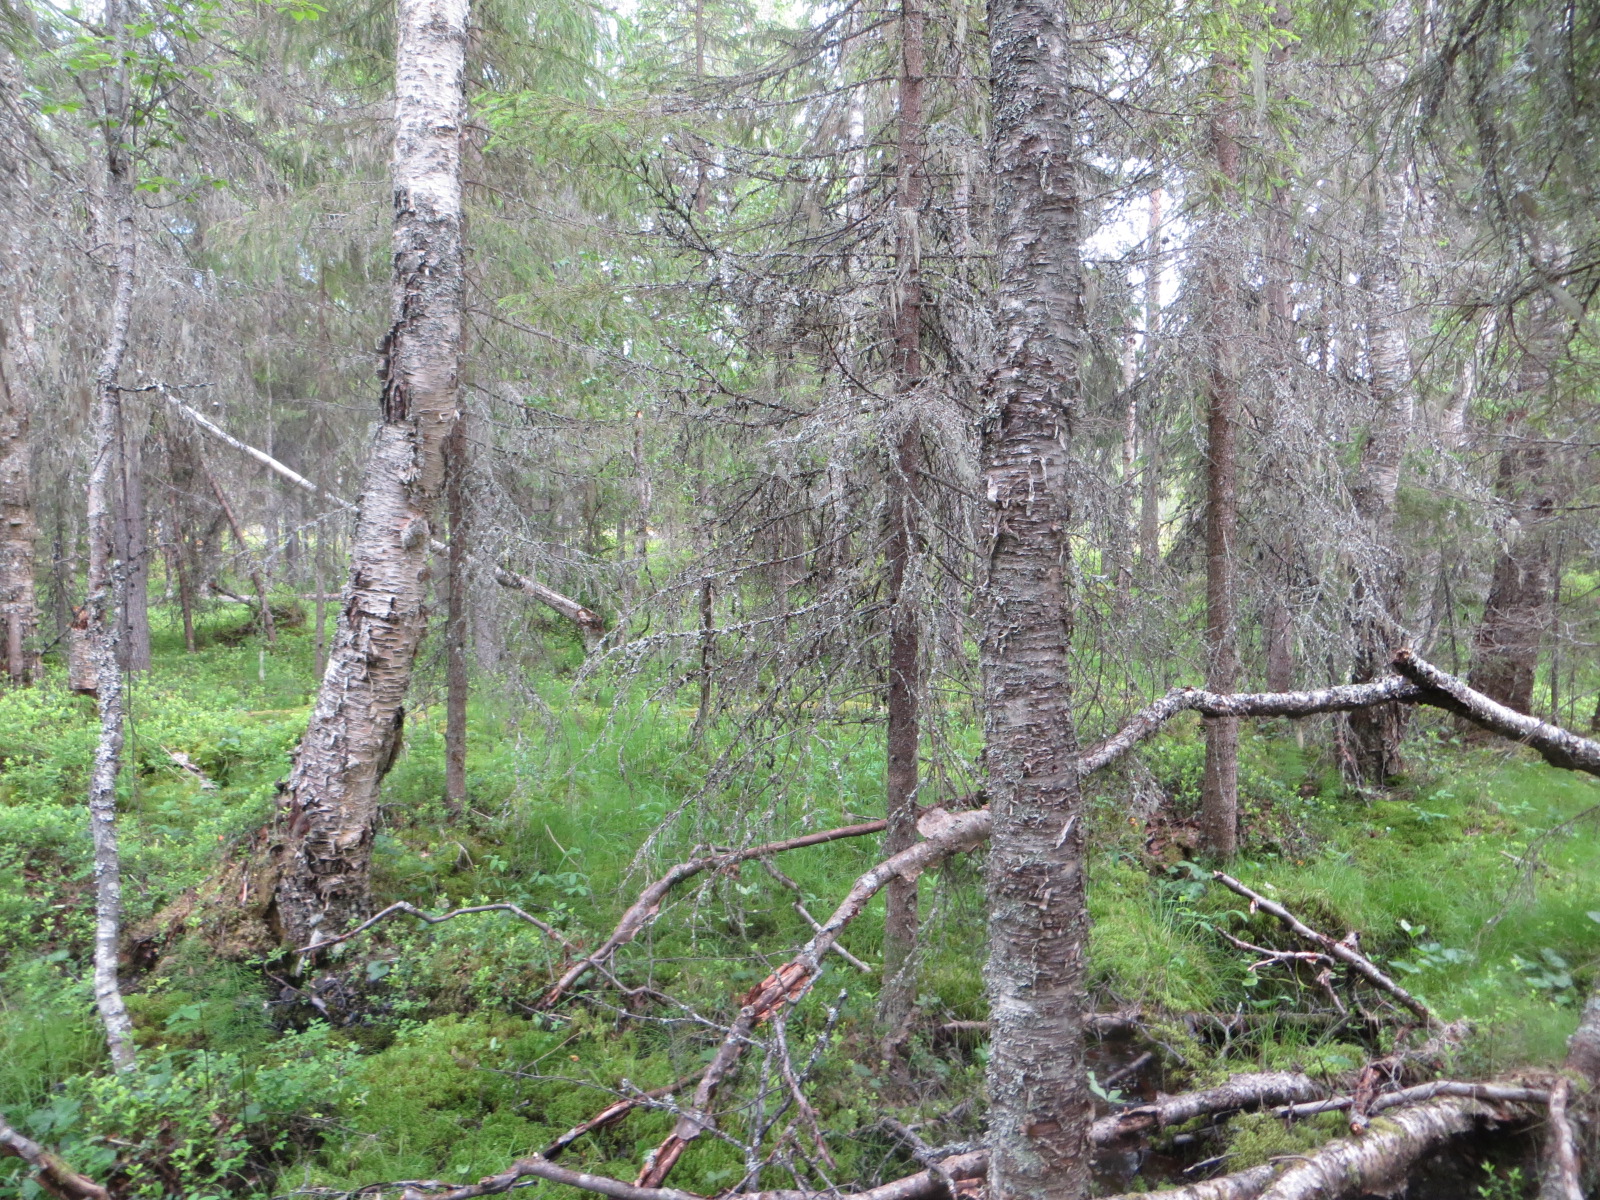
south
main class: Woodland
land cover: Spruce dominated mixed woodland
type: mire and swamp forests
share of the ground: 50 - 75 %
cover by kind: coniferous forest trees 40 %, broadleaved forest trees 30 %, shrubs 25 %, lichens and mosses 5 %
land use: Forestry
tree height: > 5 m
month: July
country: FI
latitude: 65.6092
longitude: 25.1071
